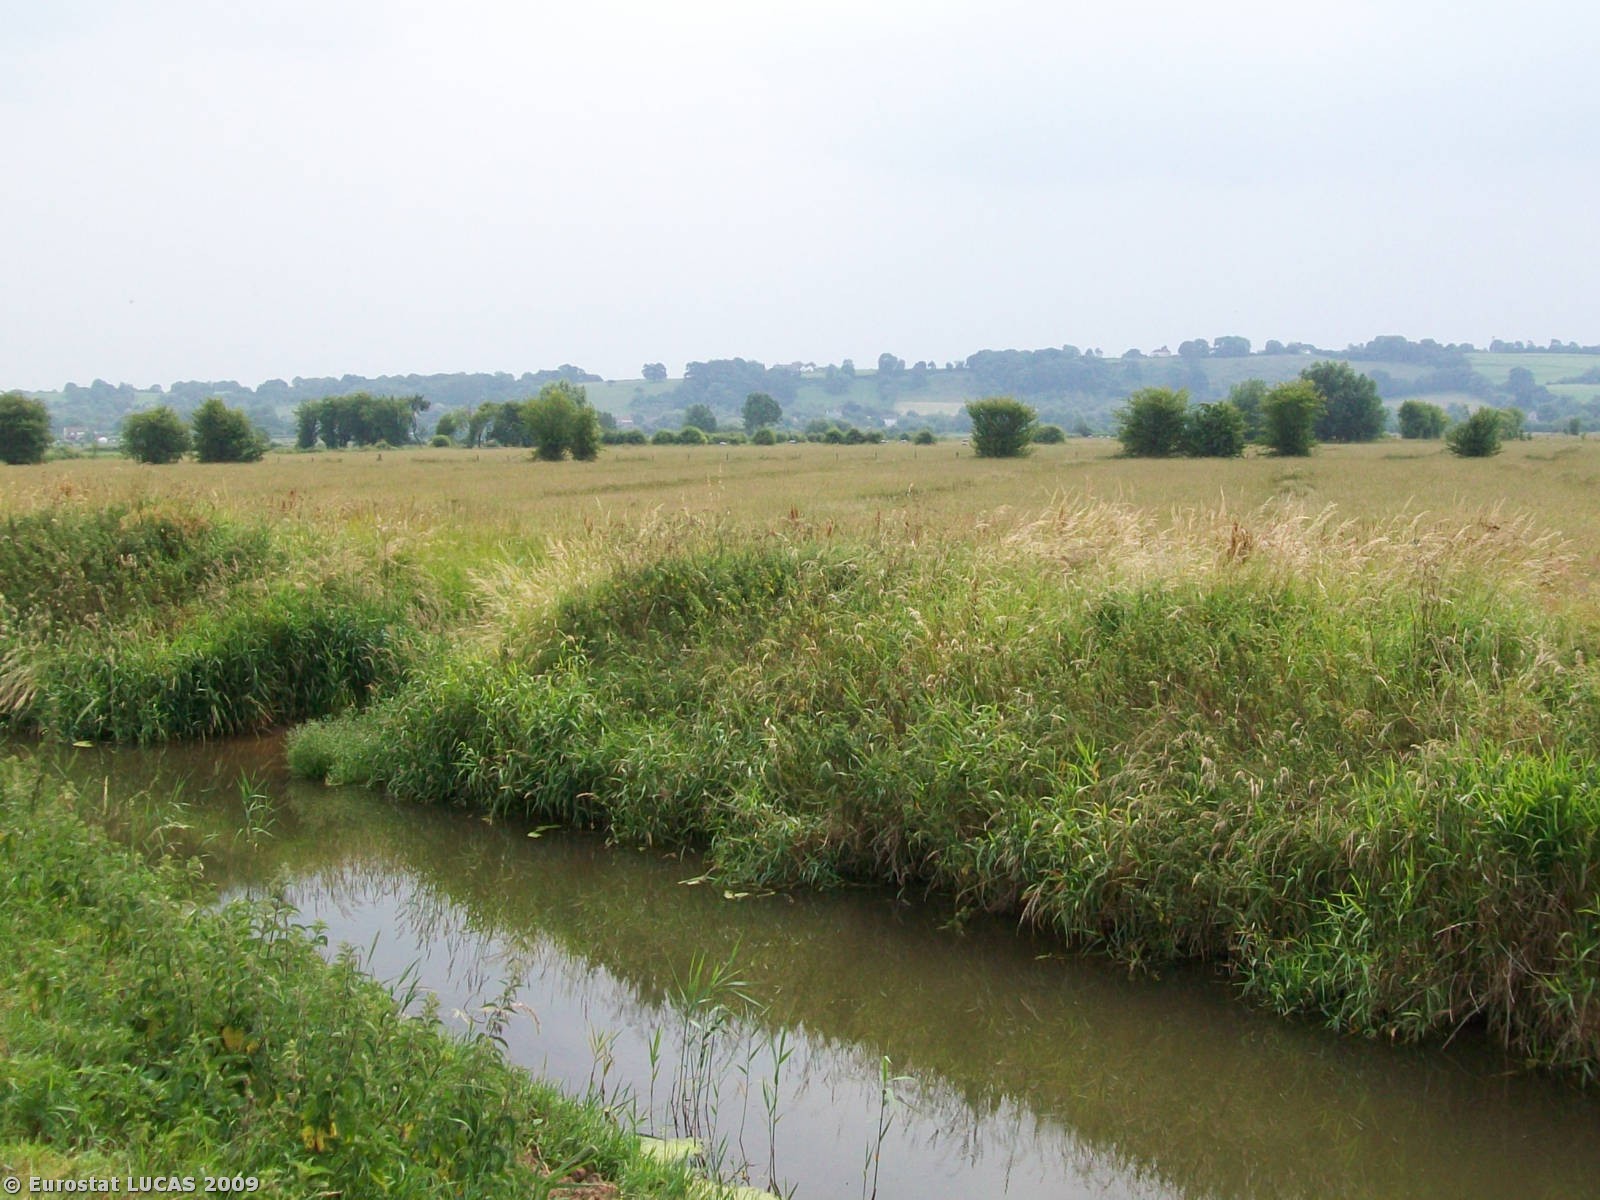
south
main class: Grassland
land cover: Grassland without tree/shrub cover
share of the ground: > 75 %
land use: Agriculture (excluding fallow land and kitchen gardens)
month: July
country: GB
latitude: 51.2286
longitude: -2.7732
